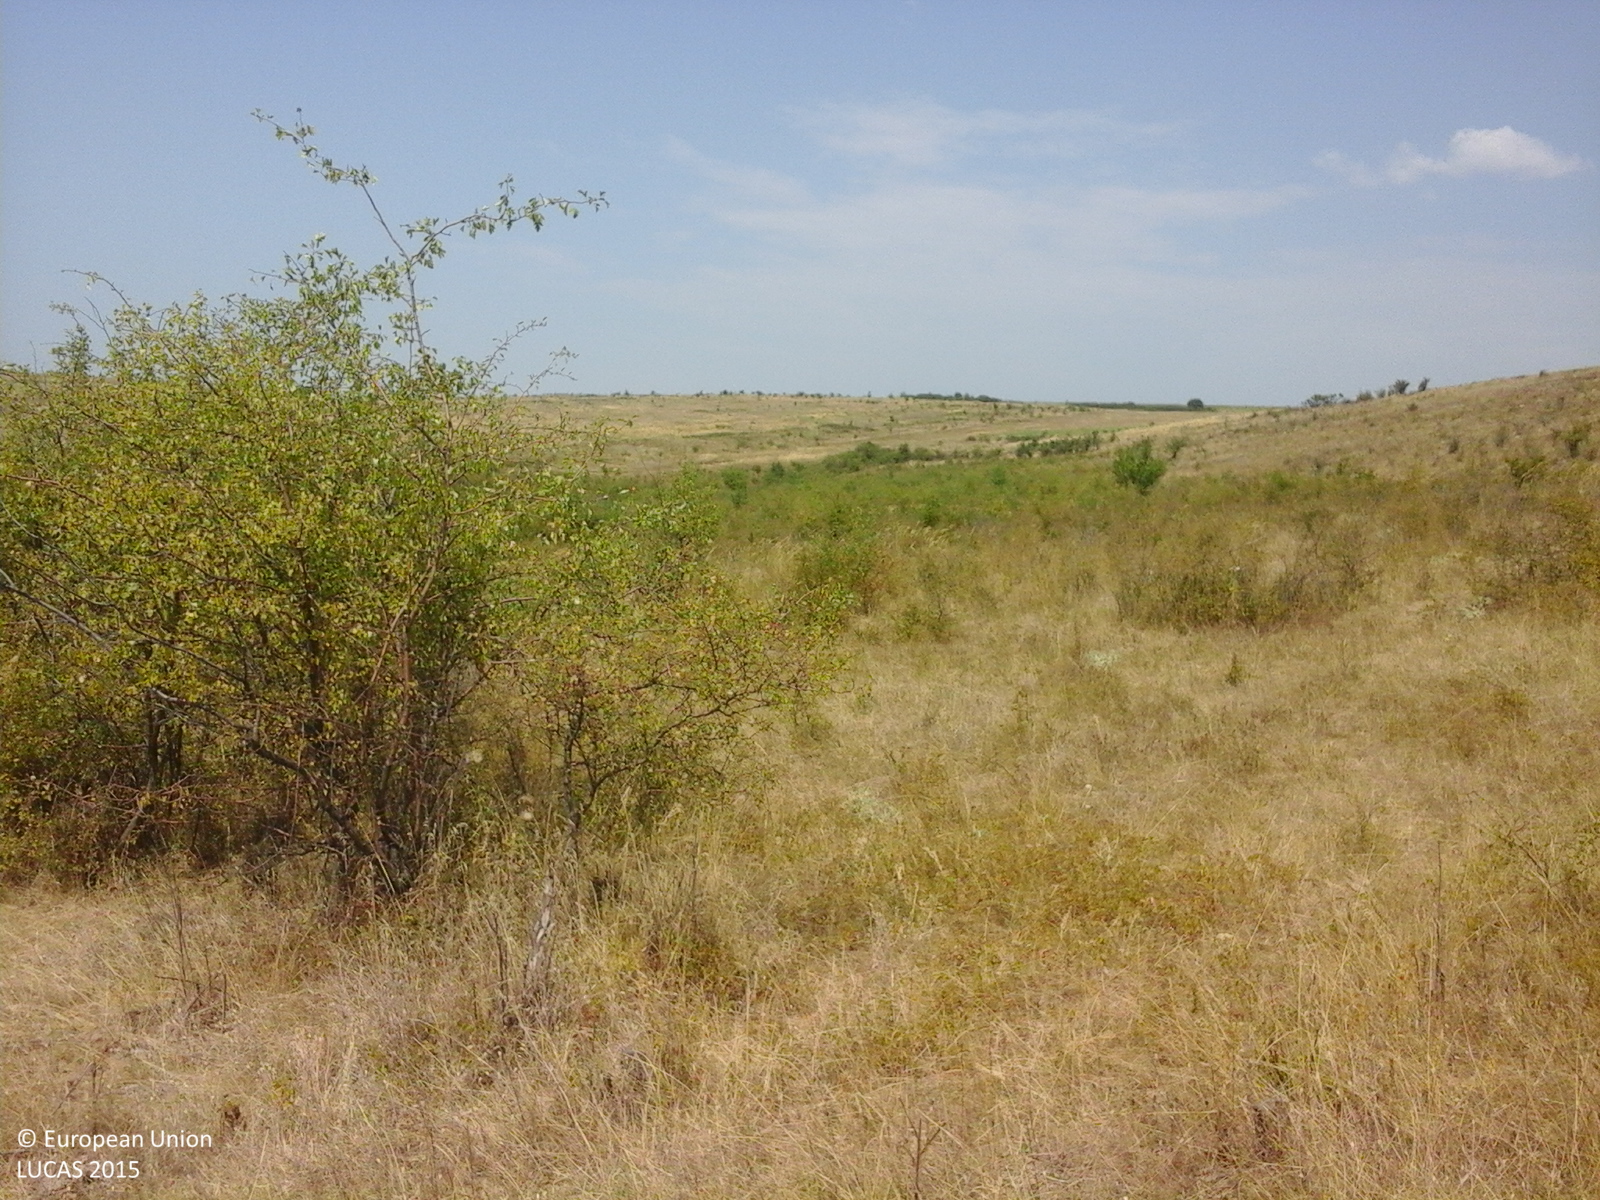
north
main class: Grassland
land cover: Grassland without tree/shrub cover
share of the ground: > 75 %
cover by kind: herbaceous plants 100 %
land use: Agriculture (excluding fallow land and kitchen gardens)
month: August
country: RO
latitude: 44.5273
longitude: 23.6070
